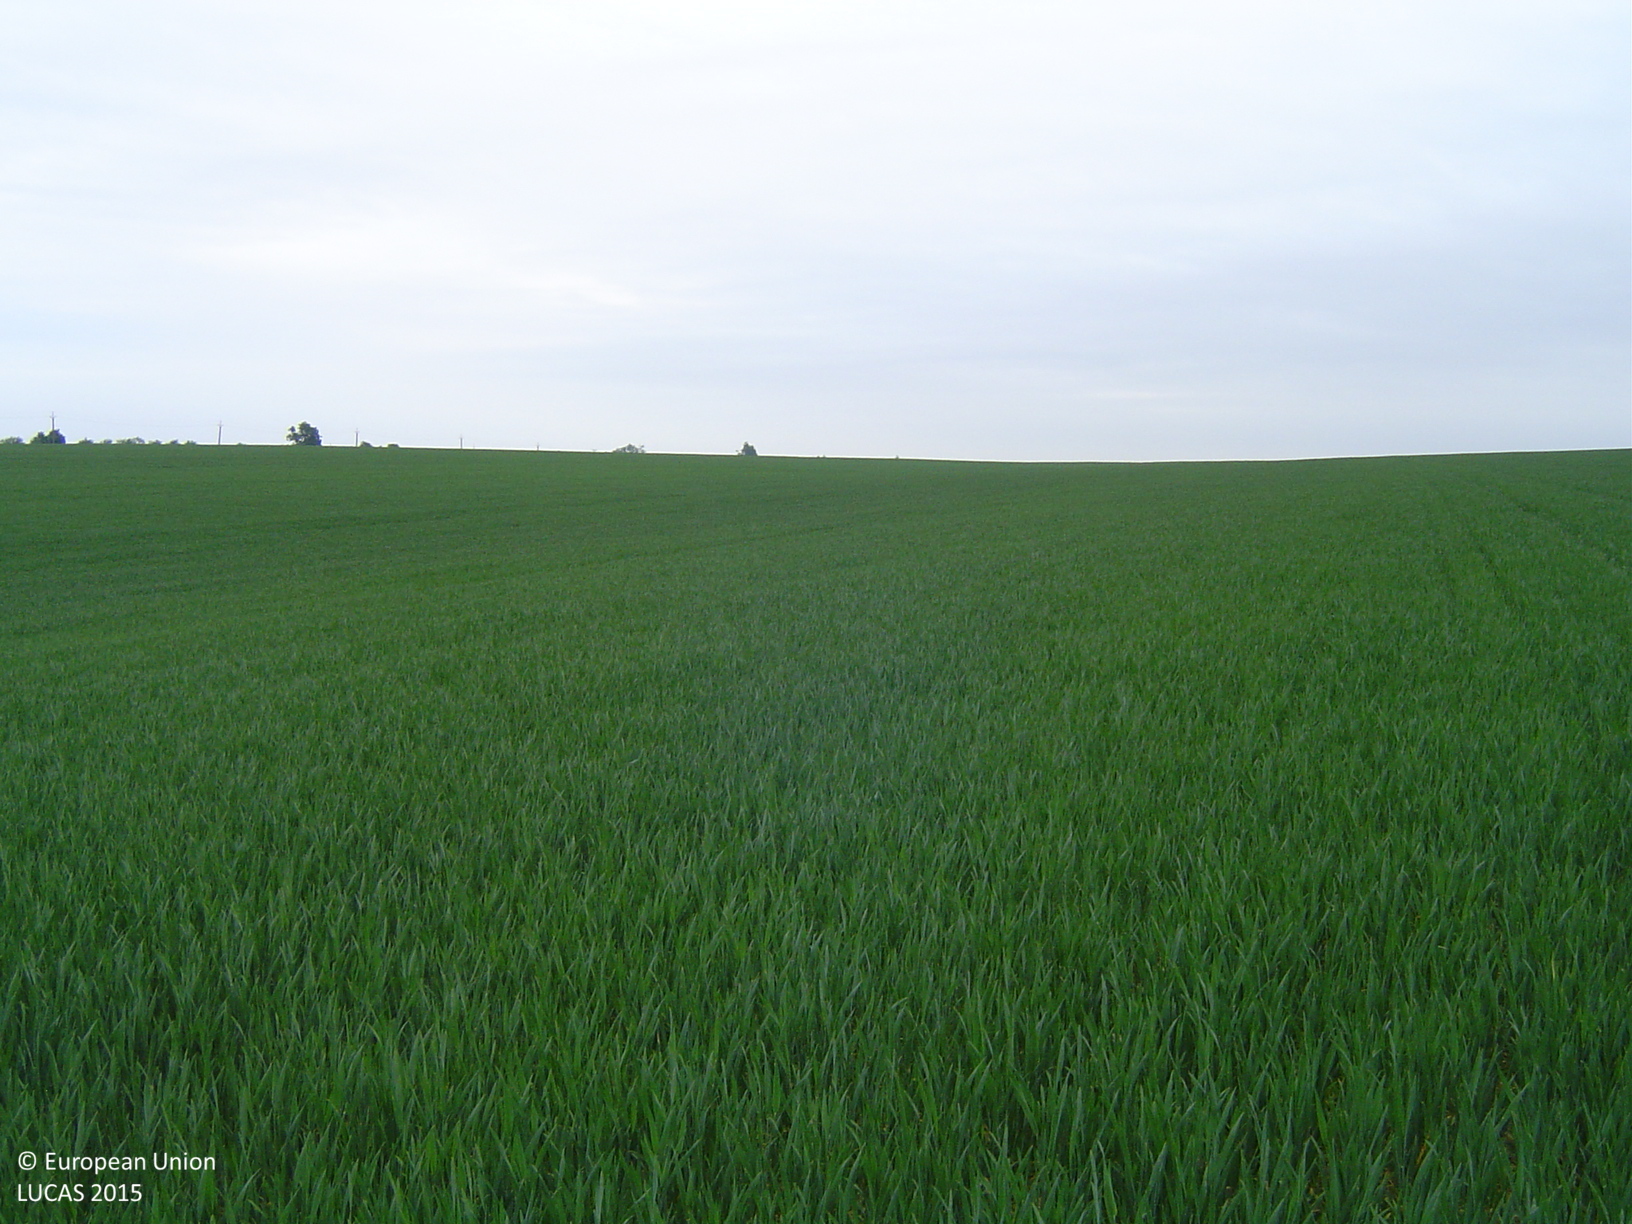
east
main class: Cropland
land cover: Barley
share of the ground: > 75 %
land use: Agriculture (excluding fallow land and kitchen gardens)
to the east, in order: Barley
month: May
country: CZ
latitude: 49.1652
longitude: 16.2459
